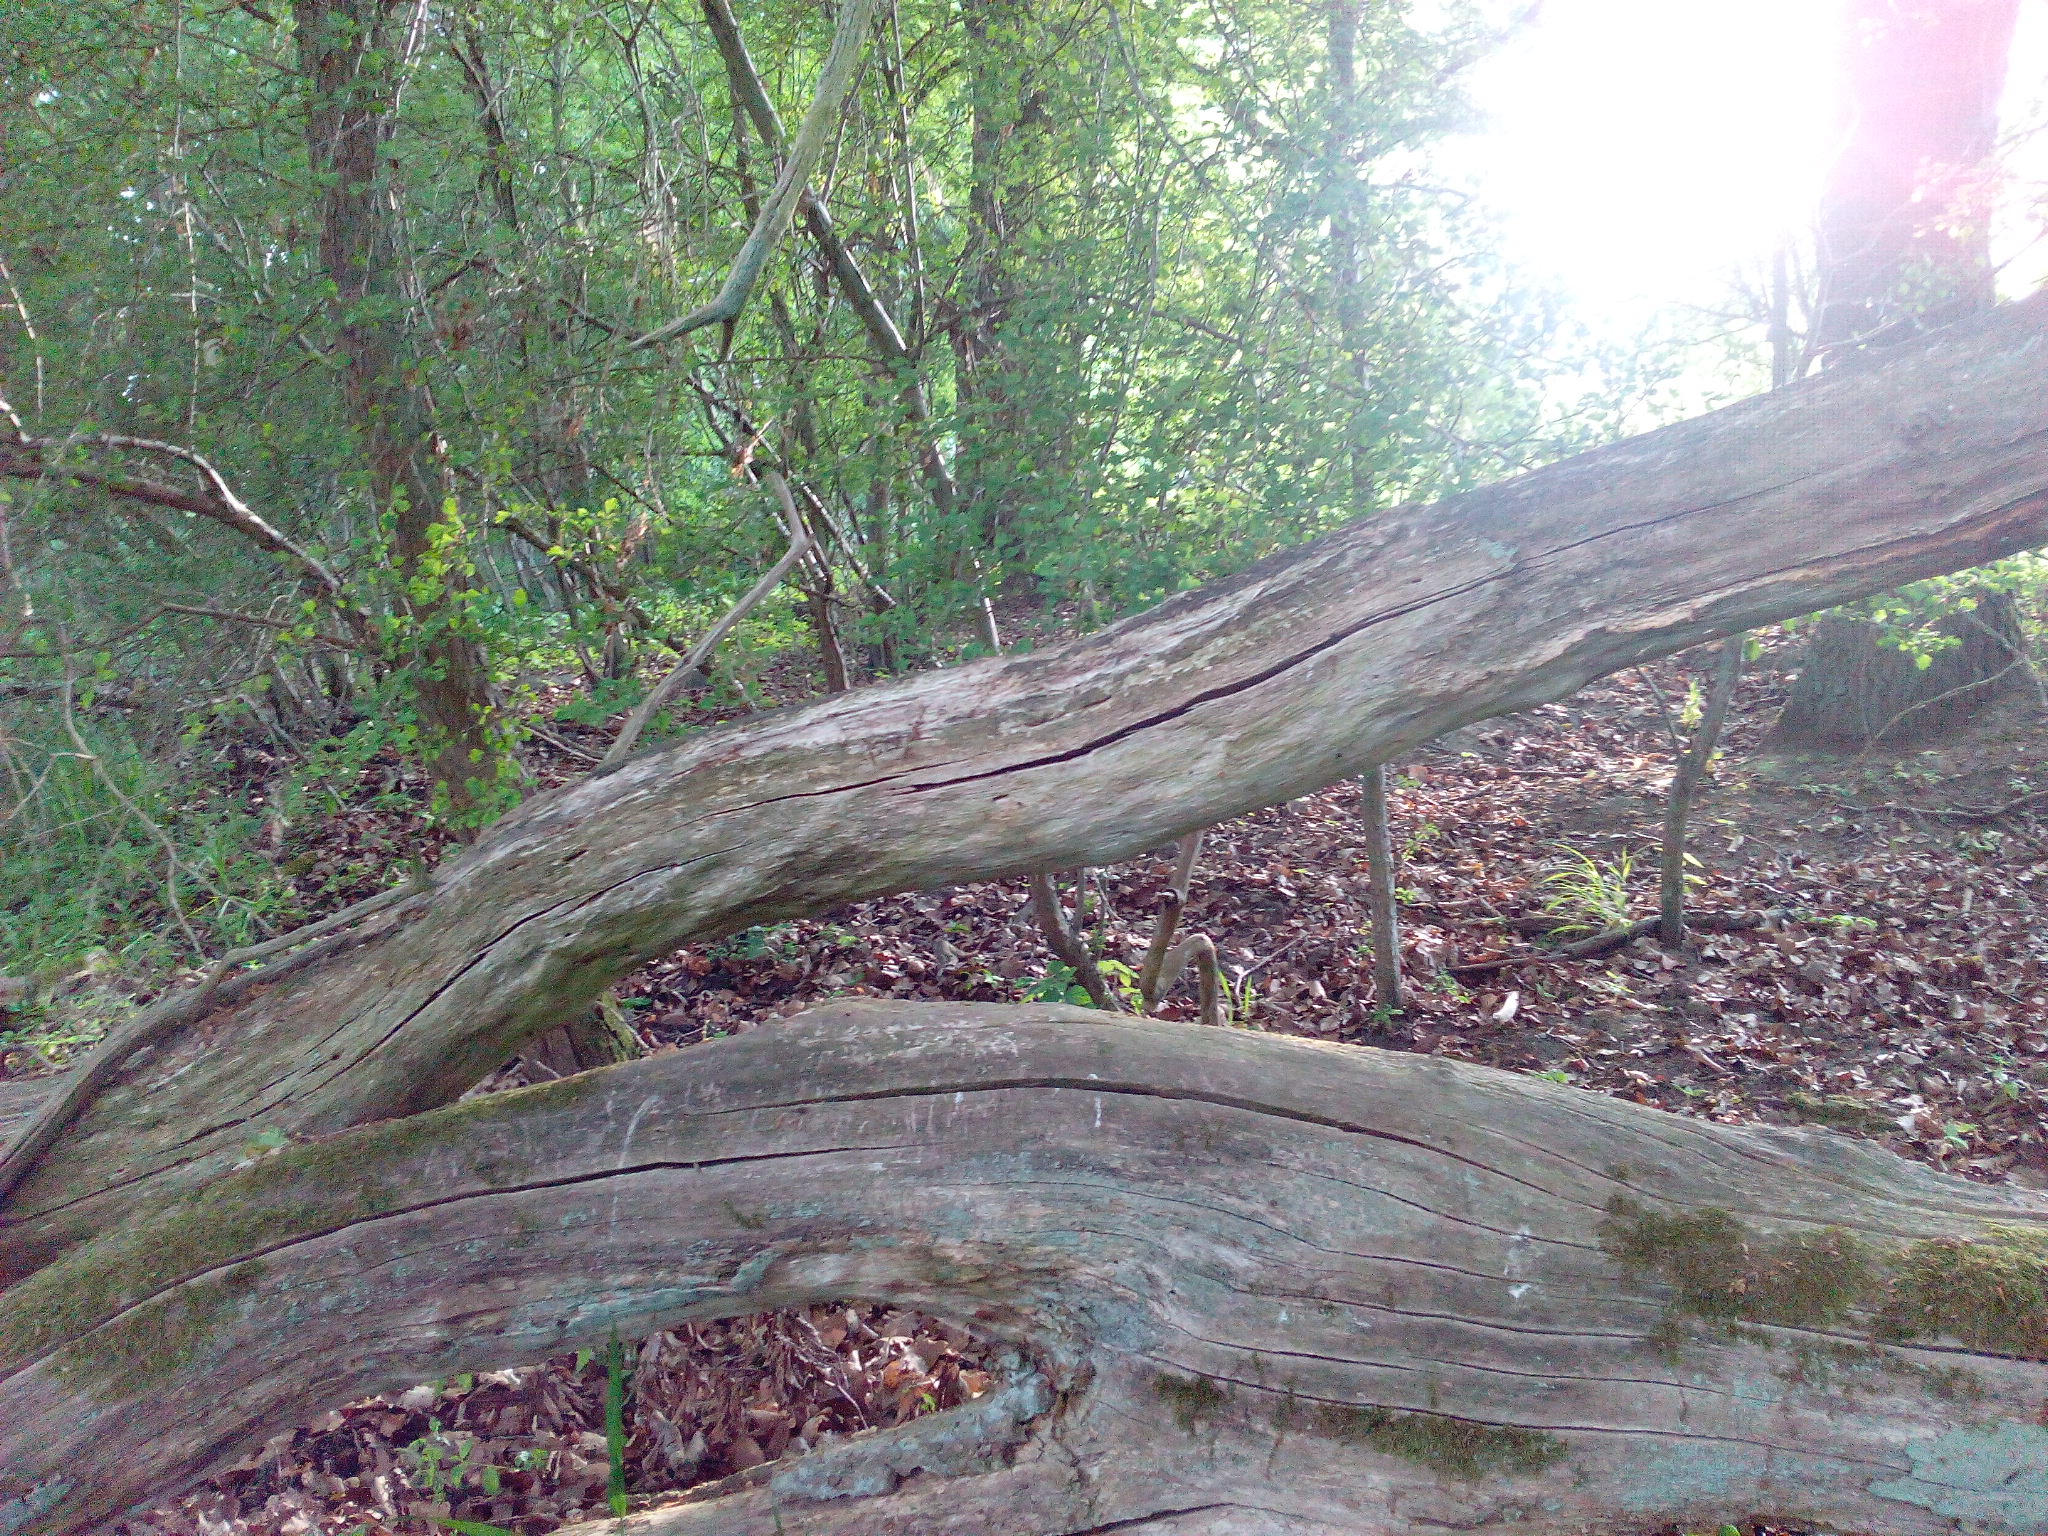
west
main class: Woodland
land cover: Broadleaved woodland
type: mesophytic deciduous forest
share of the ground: 10 - 25 %
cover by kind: herbaceous plants 40 %, broadleaved forest trees 25 %, shrubs 25 %, unconsolidated bare surface 10 %
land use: Semi-natural and natural areas not in use
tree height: > 5 m
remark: Temporary flooded
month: June
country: DE
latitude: 53.2590
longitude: 13.5827
